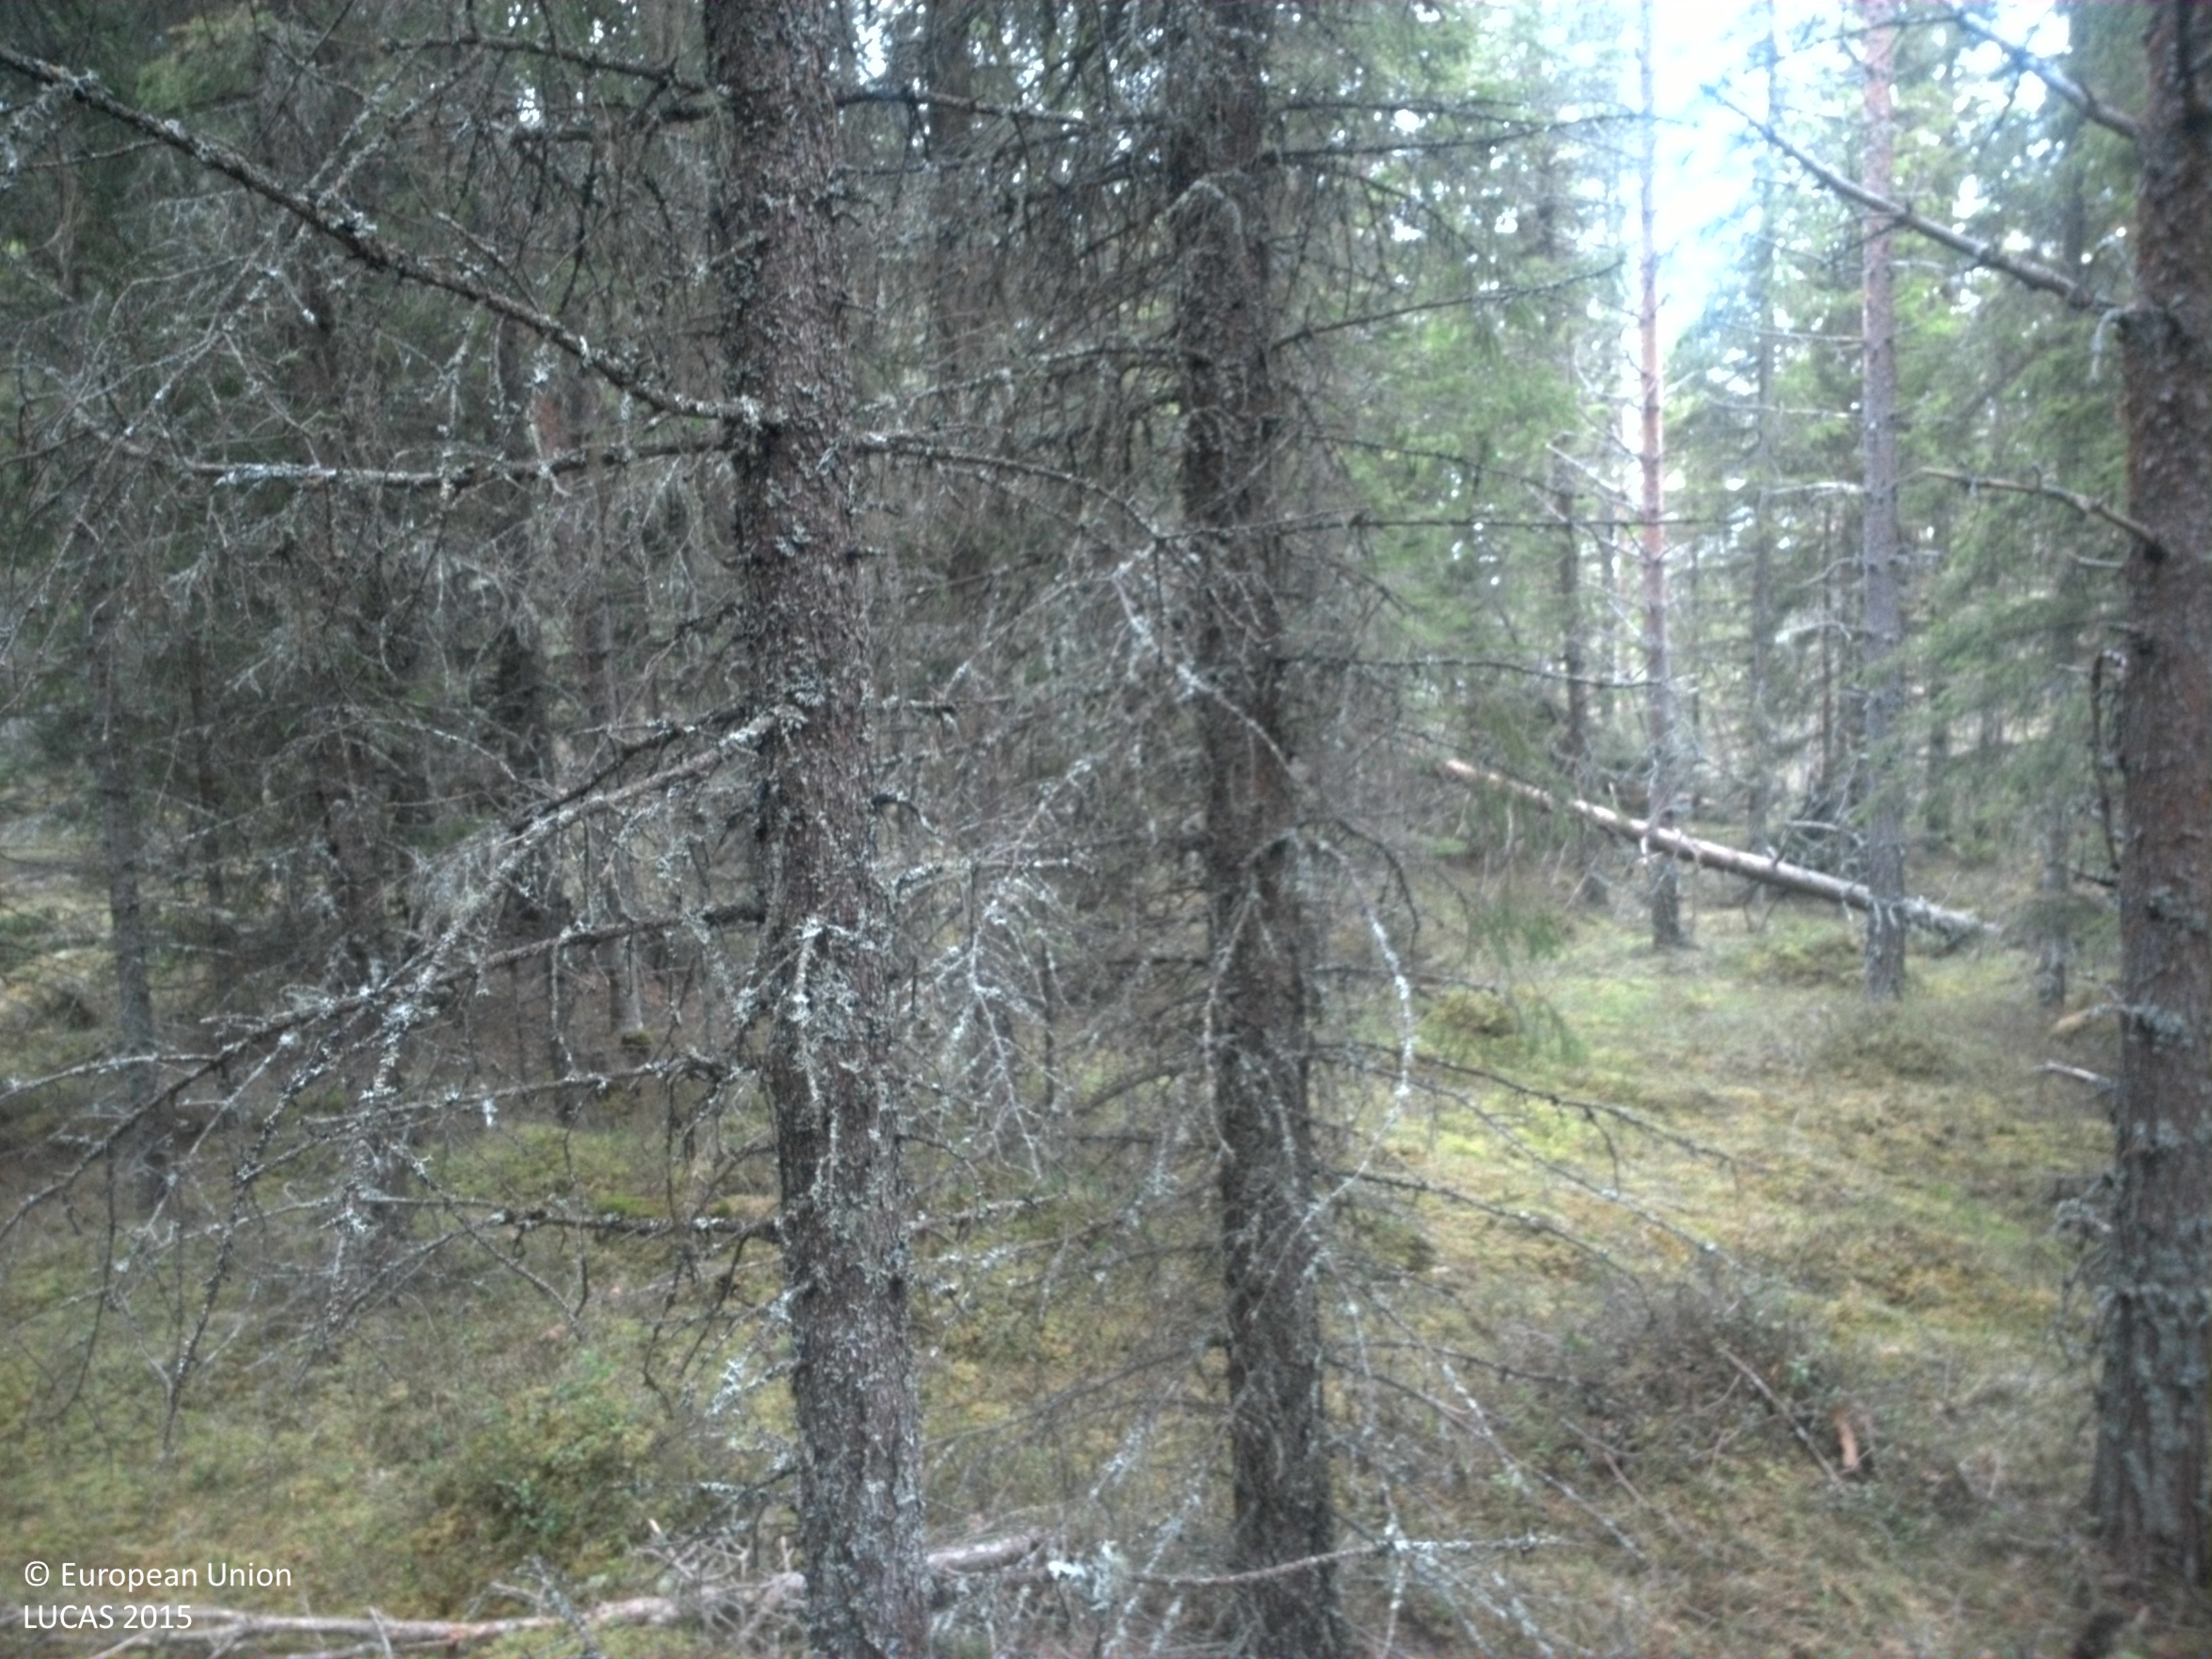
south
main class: Woodland
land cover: Spruce dominated coniferous woodland
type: boreal forest
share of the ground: > 75 %
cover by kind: coniferous forest trees 80 %, lichens and mosses 20 %
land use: Forestry
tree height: > 5 m
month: May
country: SE
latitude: 62.7060
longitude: 15.1204
